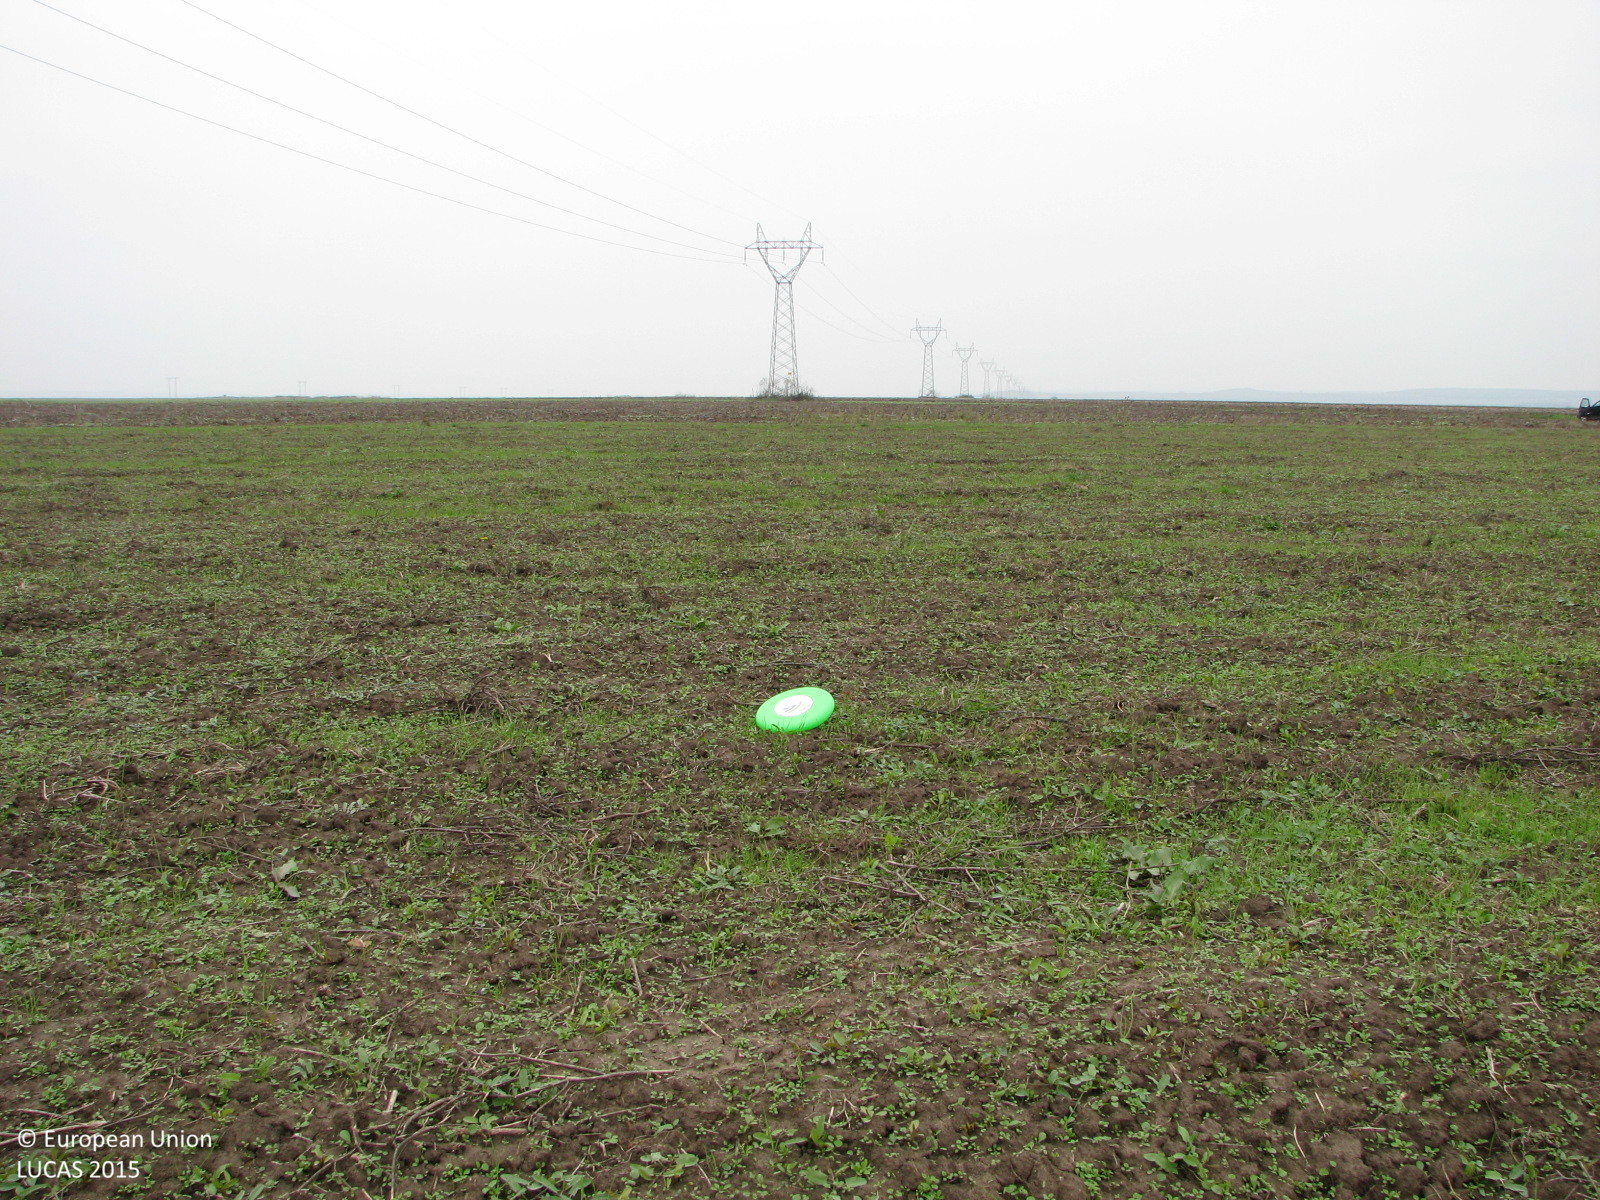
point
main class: Grassland
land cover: Spontaneously vegetated surfaces
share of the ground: 25 - 50 %
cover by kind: herbaceous plants 100 %
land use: Agriculture (excluding fallow land and kitchen gardens)
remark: Harvested field
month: October
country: BG
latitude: 42.5680
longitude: 26.7767
